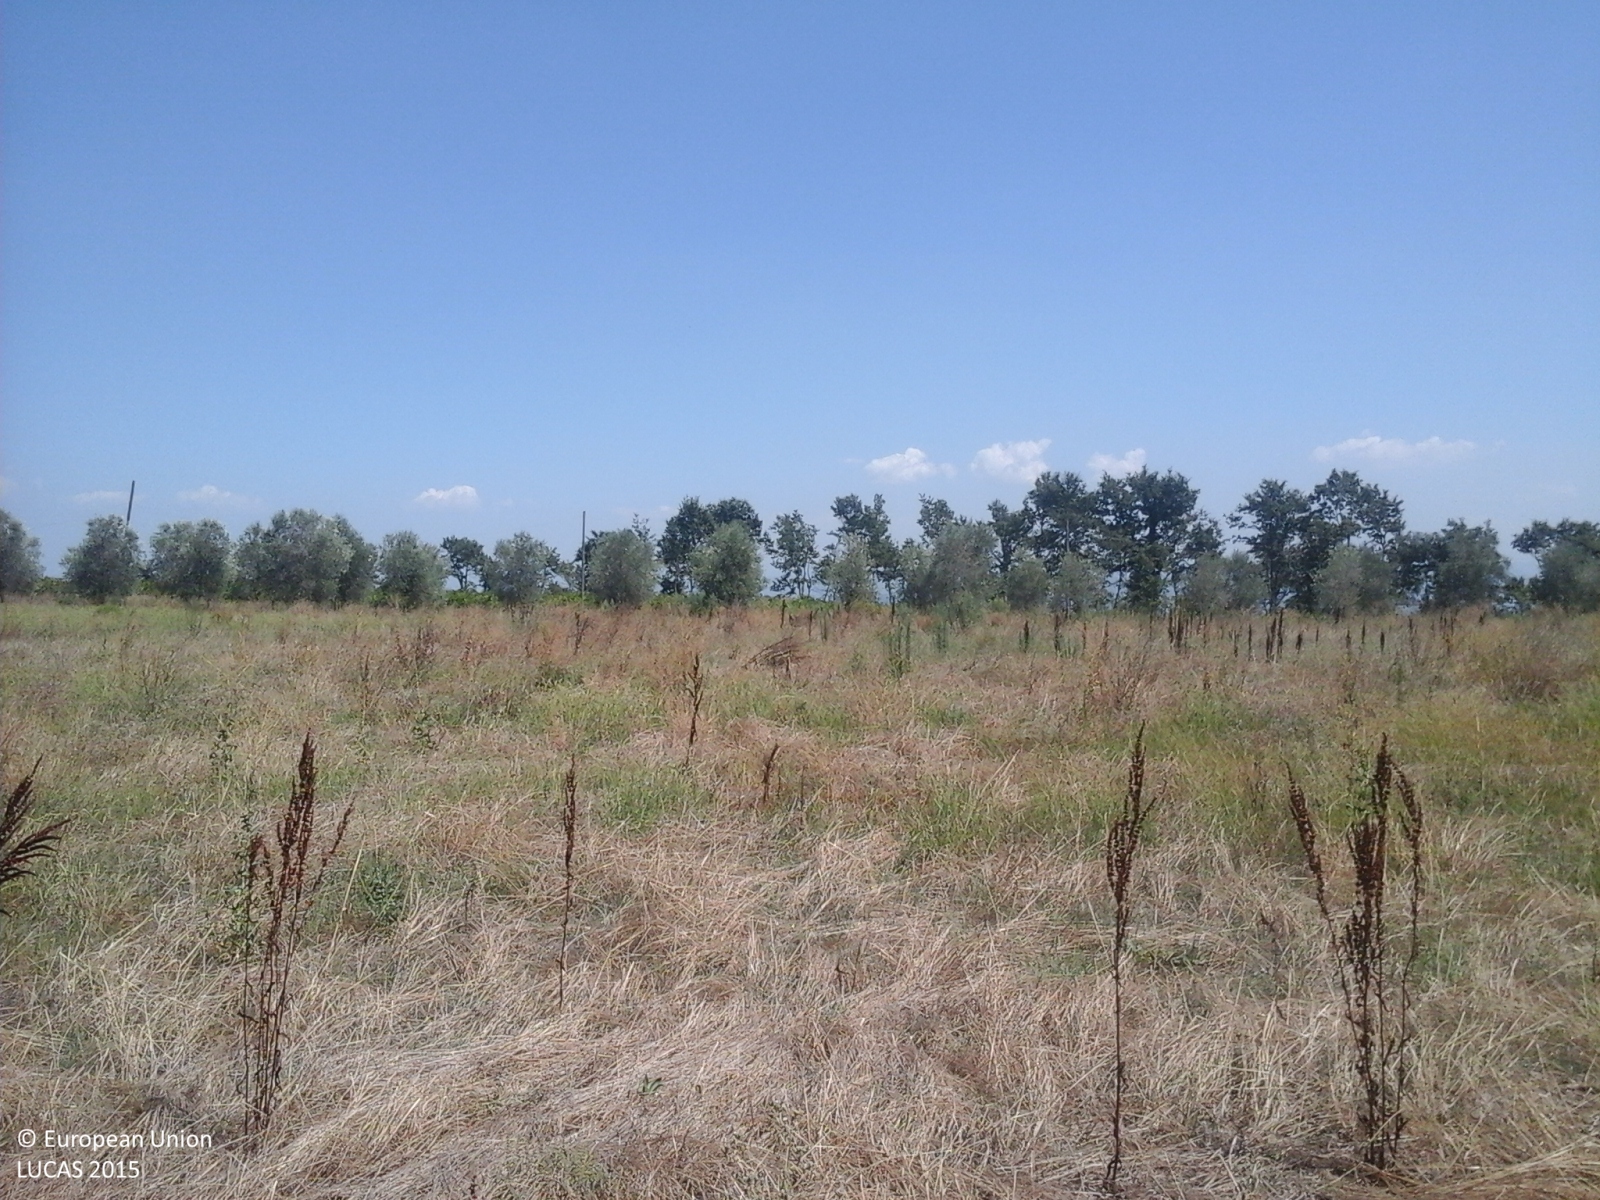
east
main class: Woodland
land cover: Broadleaved woodland
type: thermophilous deciduous forest
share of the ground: > 75 %
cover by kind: broadleaved forest trees 100 %
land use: Forestry
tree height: > 5 m
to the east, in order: Broadleaved woodland; Grassland without tree/shrub cover; Olive groves; Tracks; Lines of trees; Vineyards
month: August
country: IT
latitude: 42.5180
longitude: 12.3657
